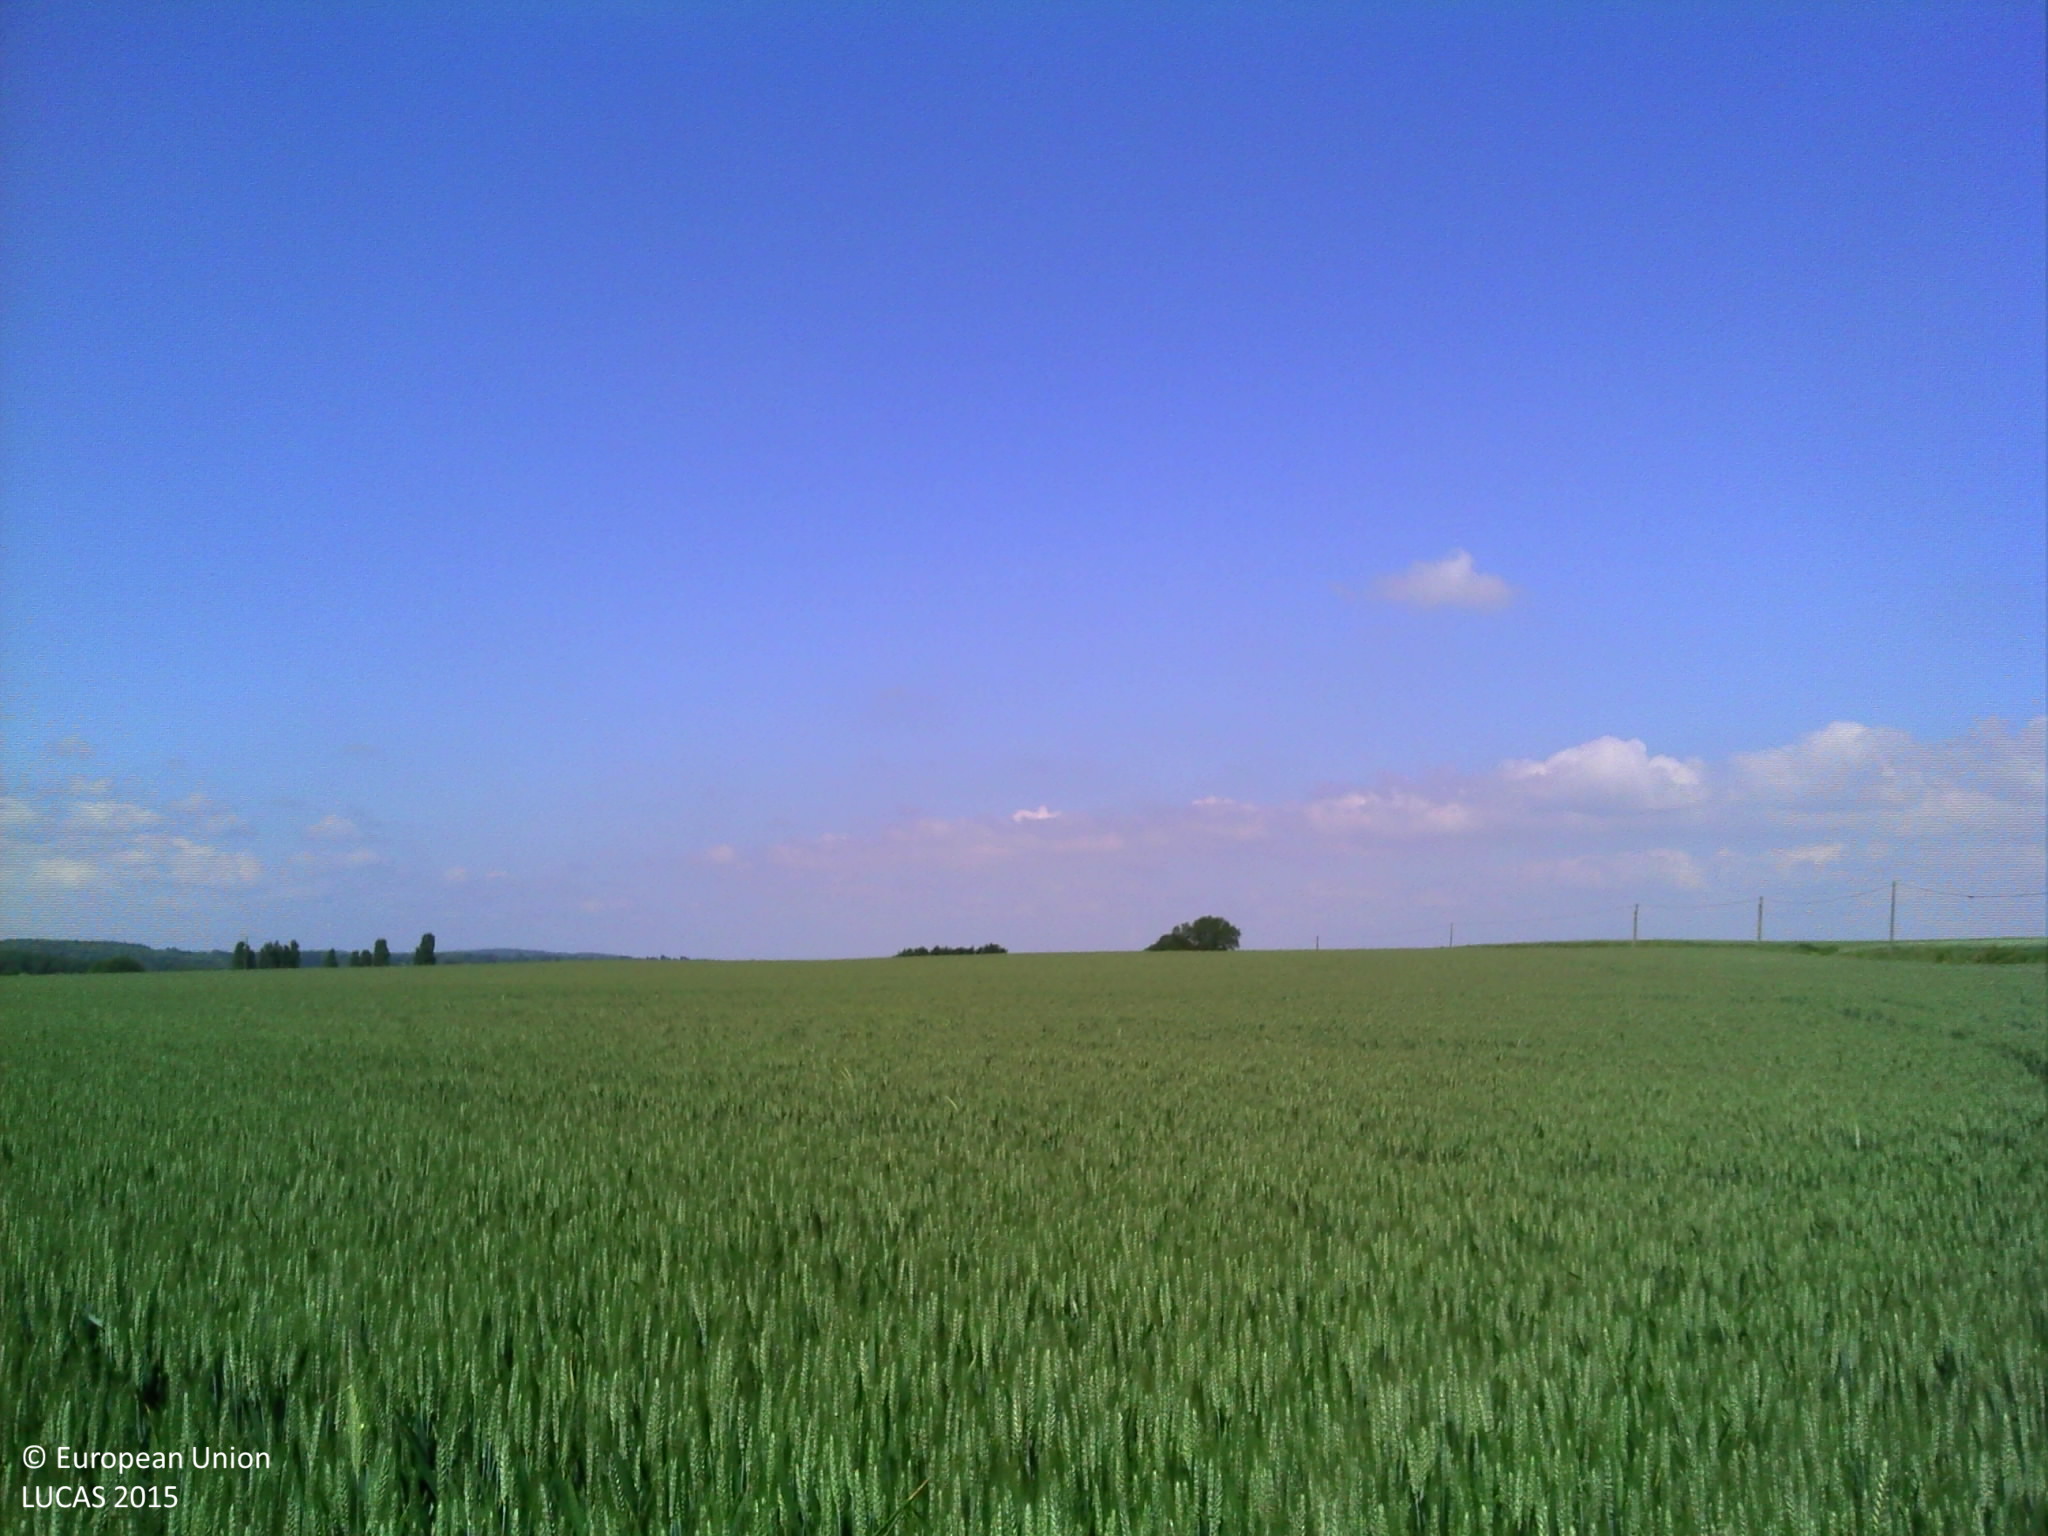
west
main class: Cropland
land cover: Common wheat
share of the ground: > 75 %
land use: Agriculture (excluding fallow land and kitchen gardens)
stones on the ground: 10 - 25 %
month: May
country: FR
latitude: 48.1066
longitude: -0.0613
